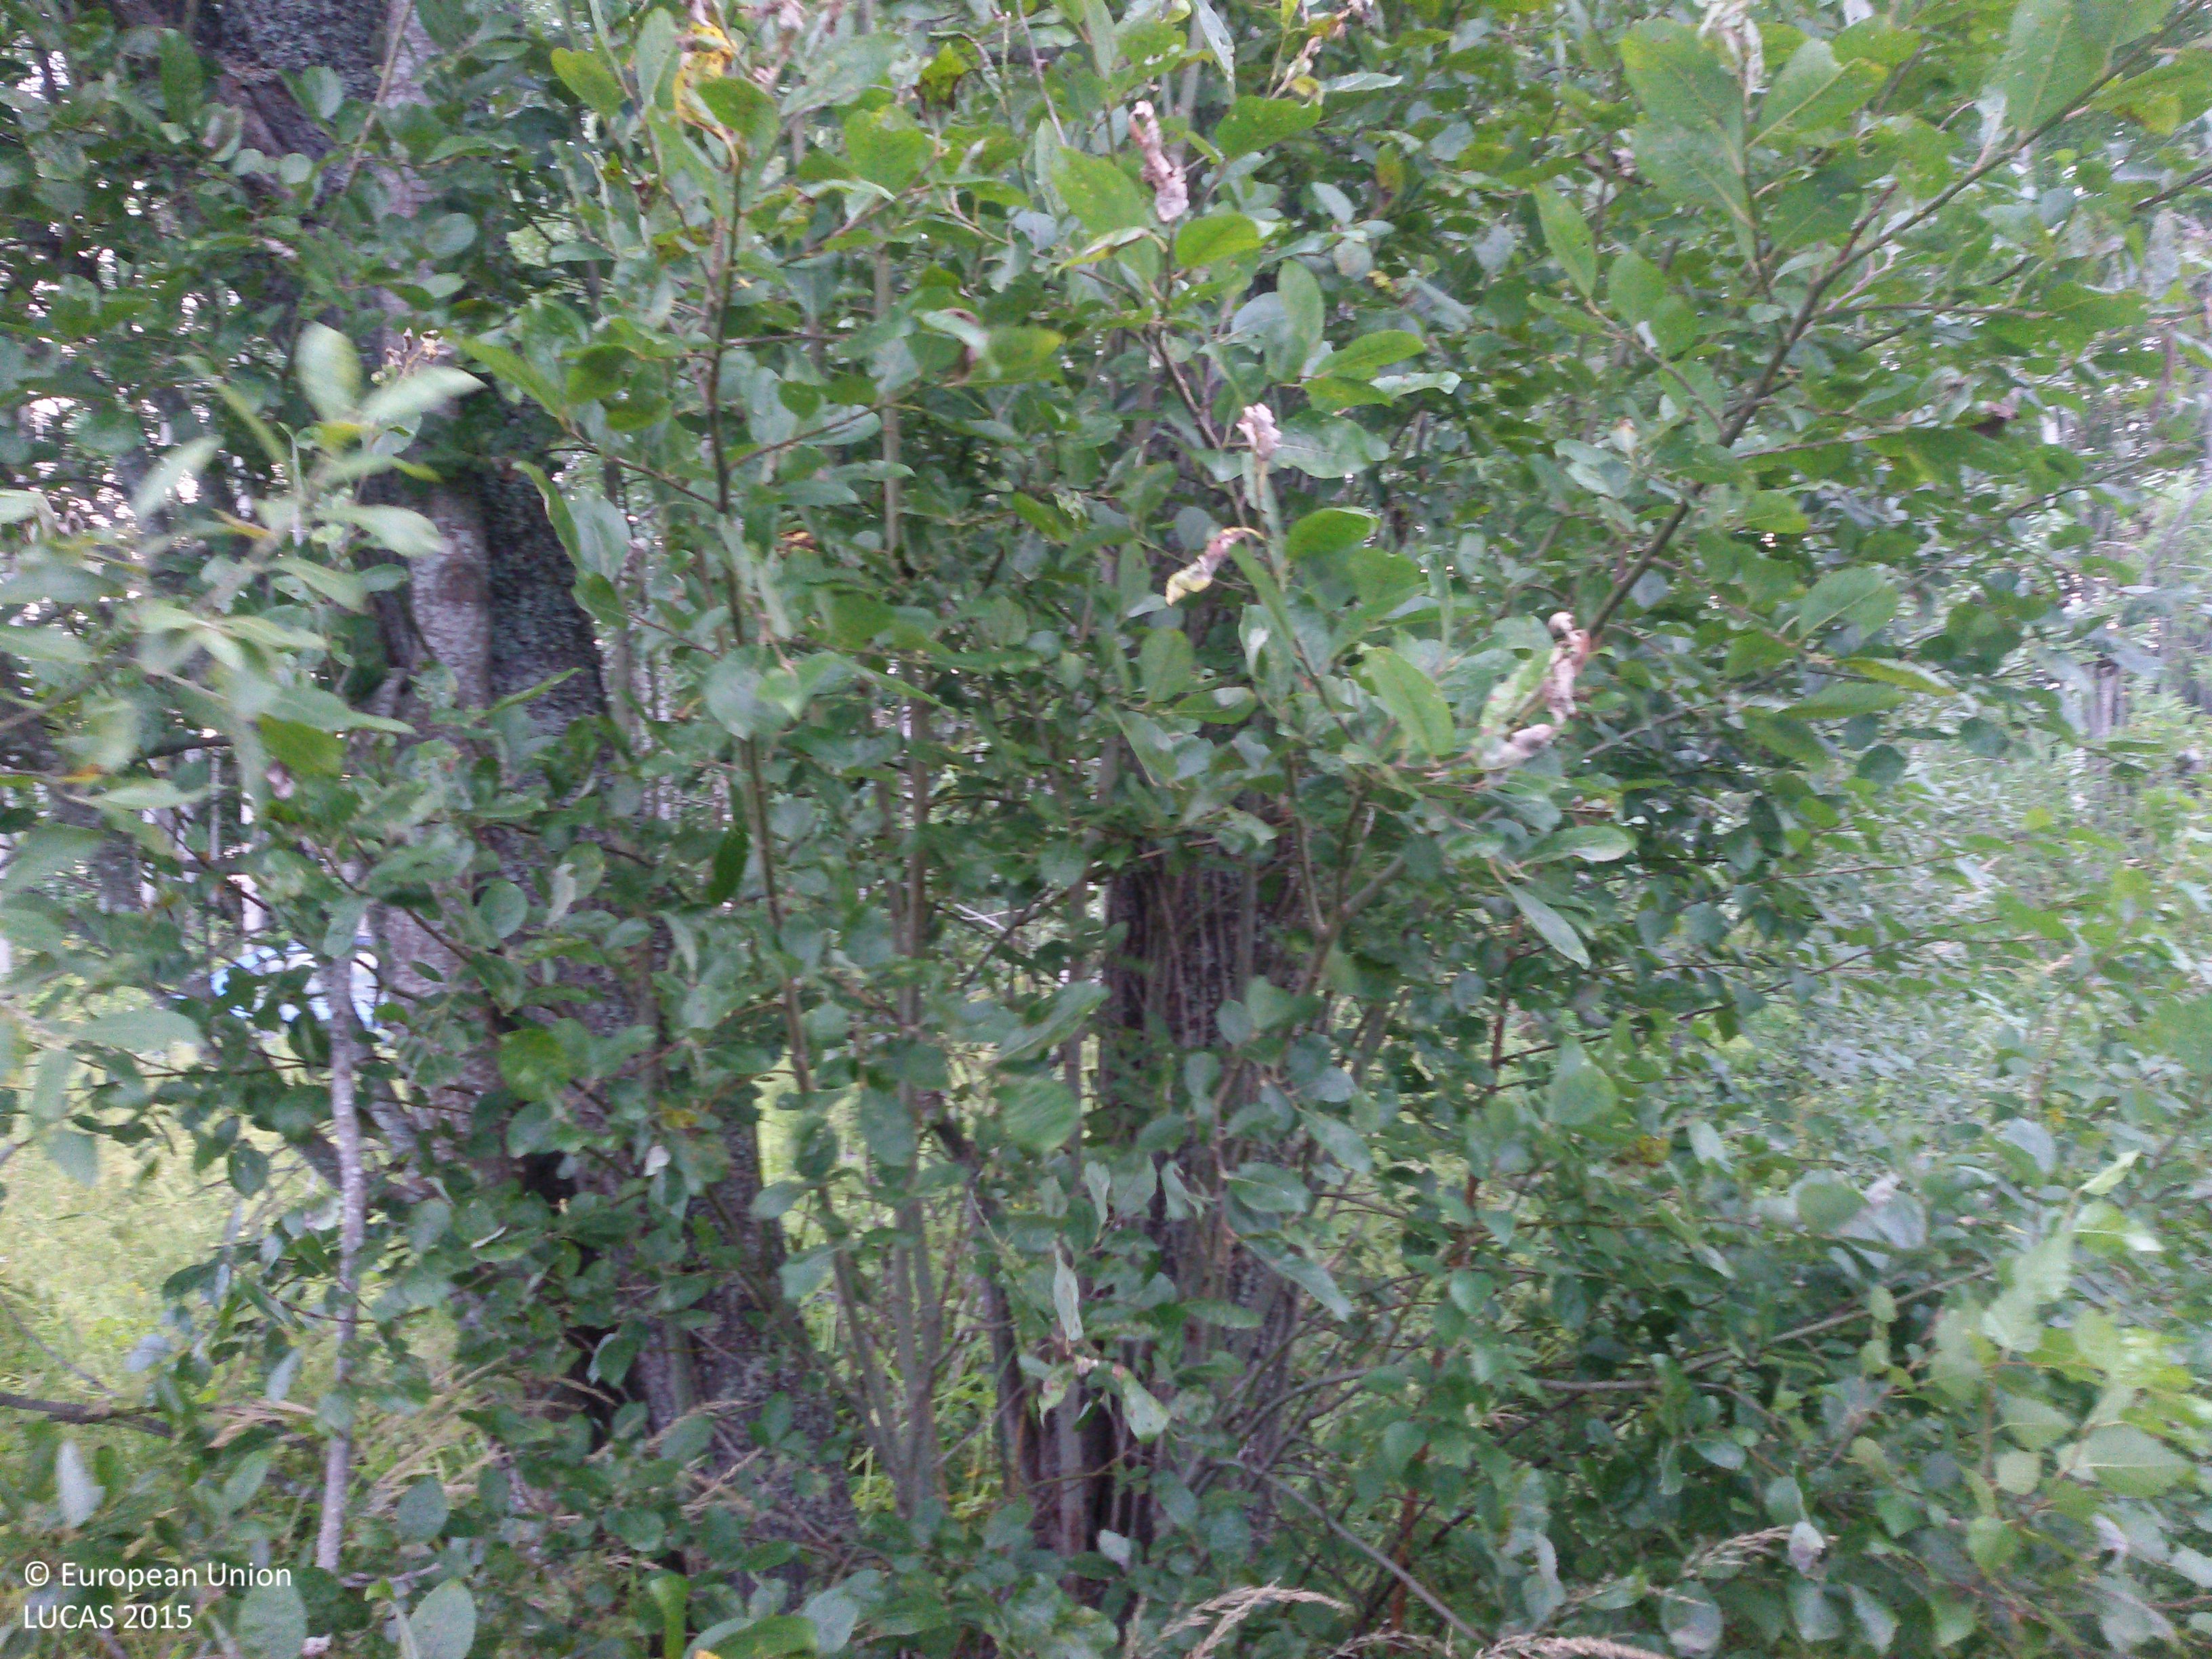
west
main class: Woodland
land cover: Broadleaved woodland
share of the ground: 25 - 50 %
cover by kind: herbaceous plants 50 %, broadleaved forest trees 30 %, shrubs 20 %
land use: Semi-natural and natural areas not in use
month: August
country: SE
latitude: 60.5337
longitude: 16.5675
